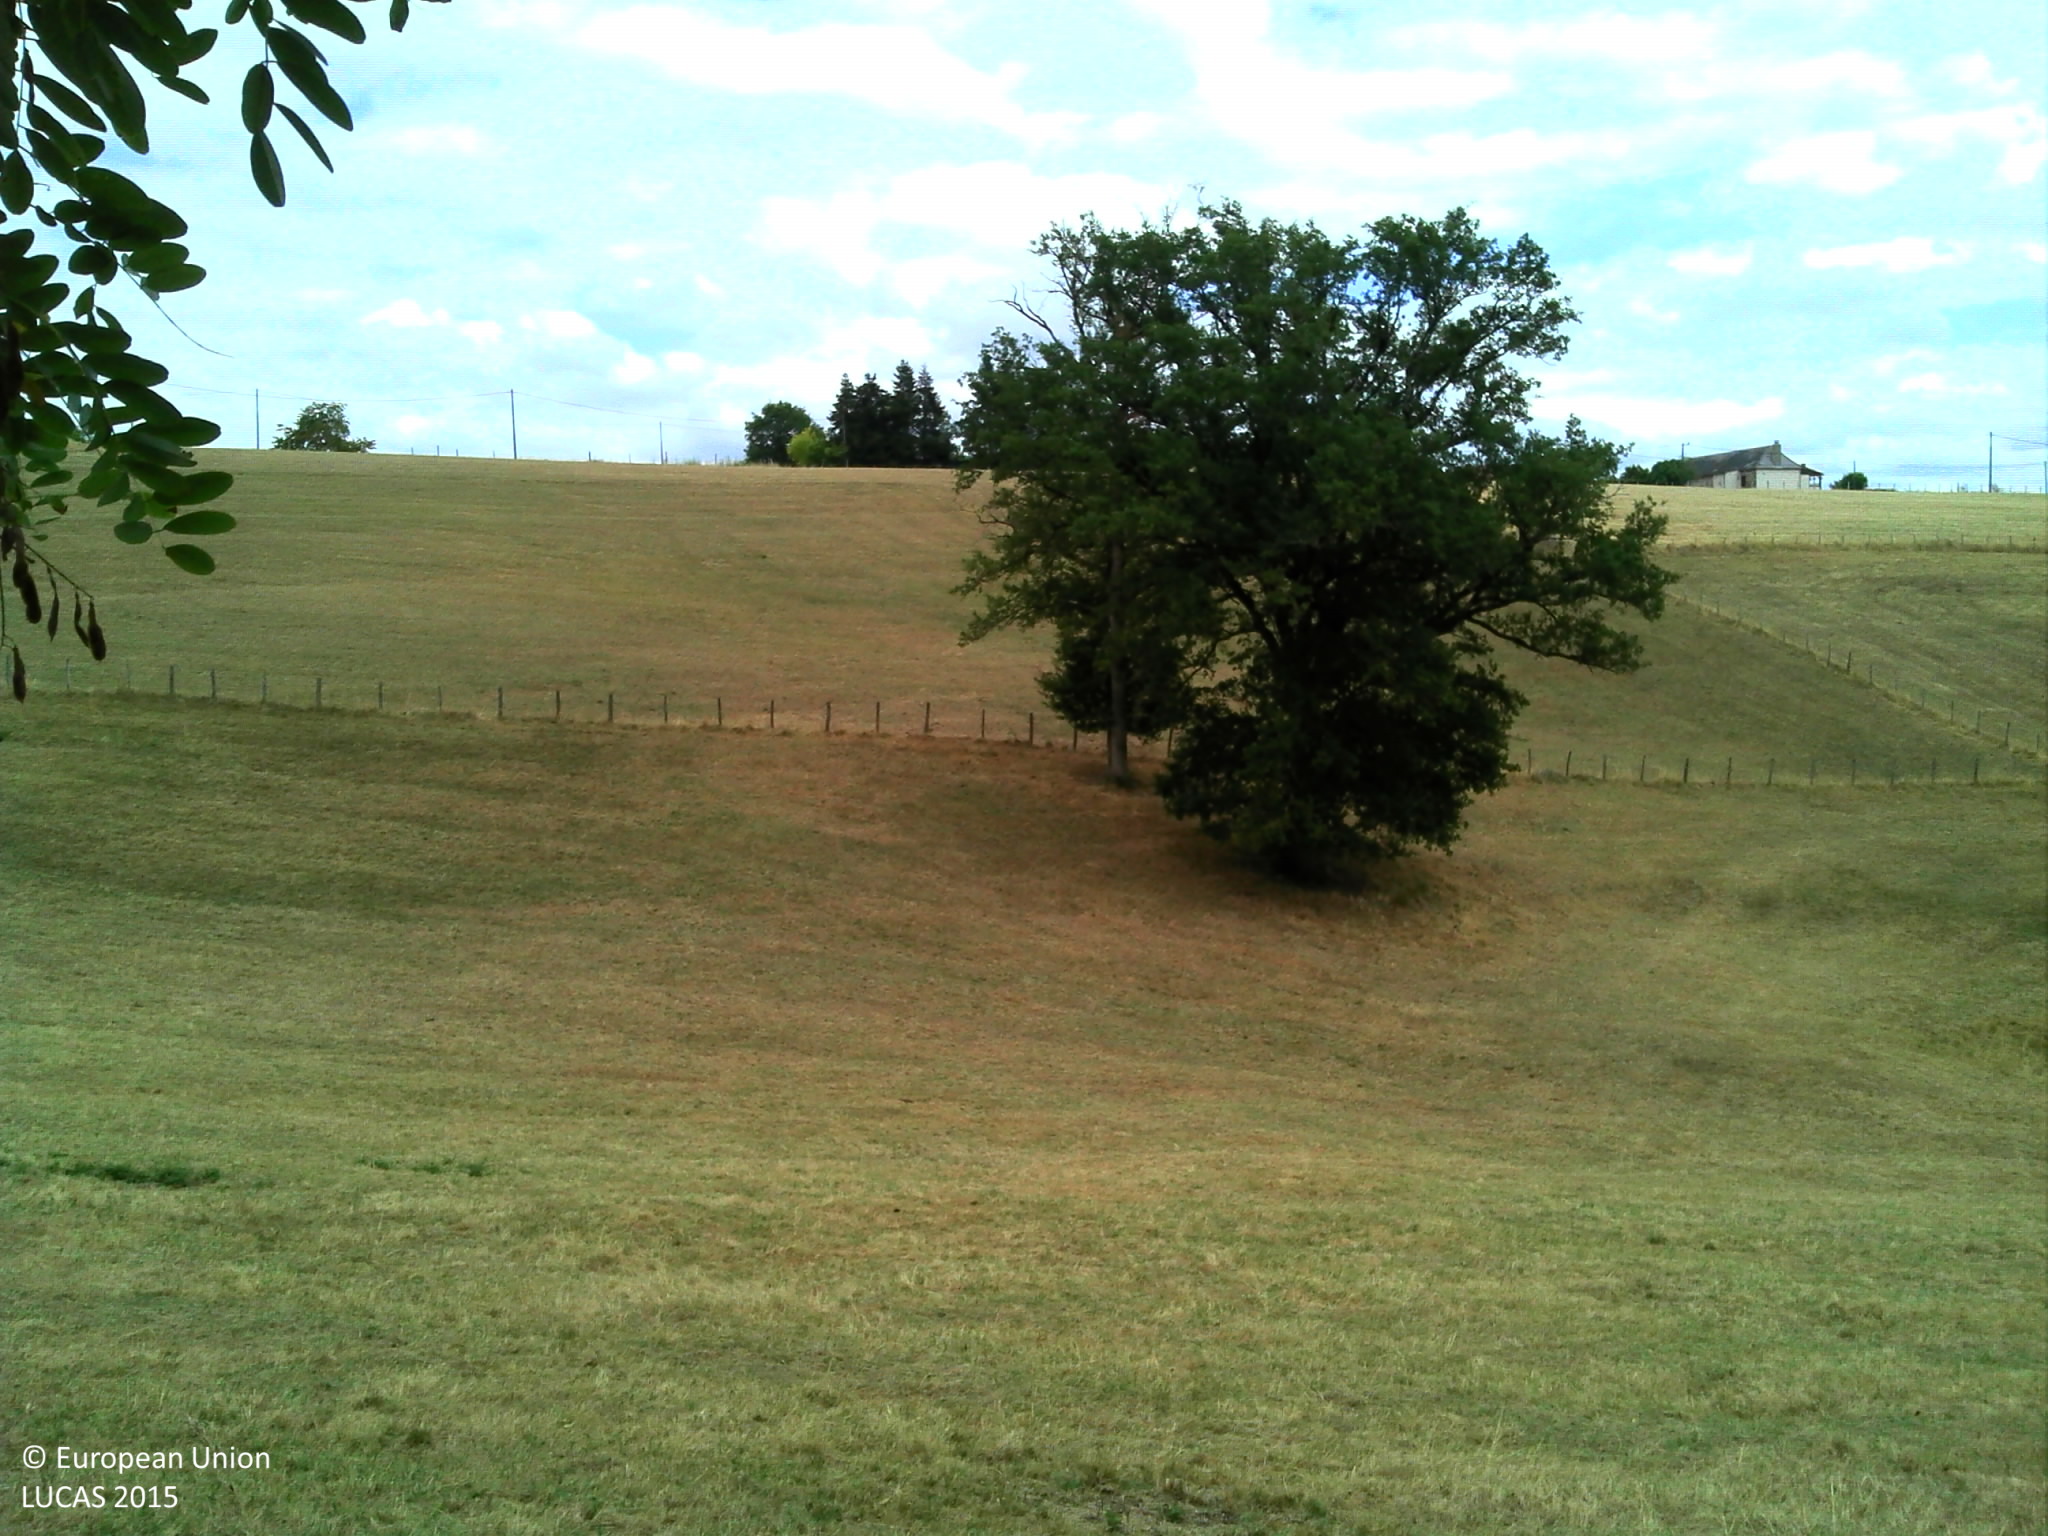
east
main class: Grassland
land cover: Grassland with sparse tree/shrub cover
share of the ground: > 75 %
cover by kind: herbaceous plants 90 %, broadleaved forest trees 5 %, lichens and mosses 5 %
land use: Agriculture (excluding fallow land and kitchen gardens)
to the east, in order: Grassland with sparse tree/shrub cover; Grassland without tree/shrub cover; Single bushes/trees; Fences; Grassland without tree/shrub cover; Fences; Grass margins; Electric lines; Ditches and canals; Paved roads, cycling and walking lanes; Electric lines; Ditches and canals; Tracks
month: July
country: FR
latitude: 45.1716
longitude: 1.4059
